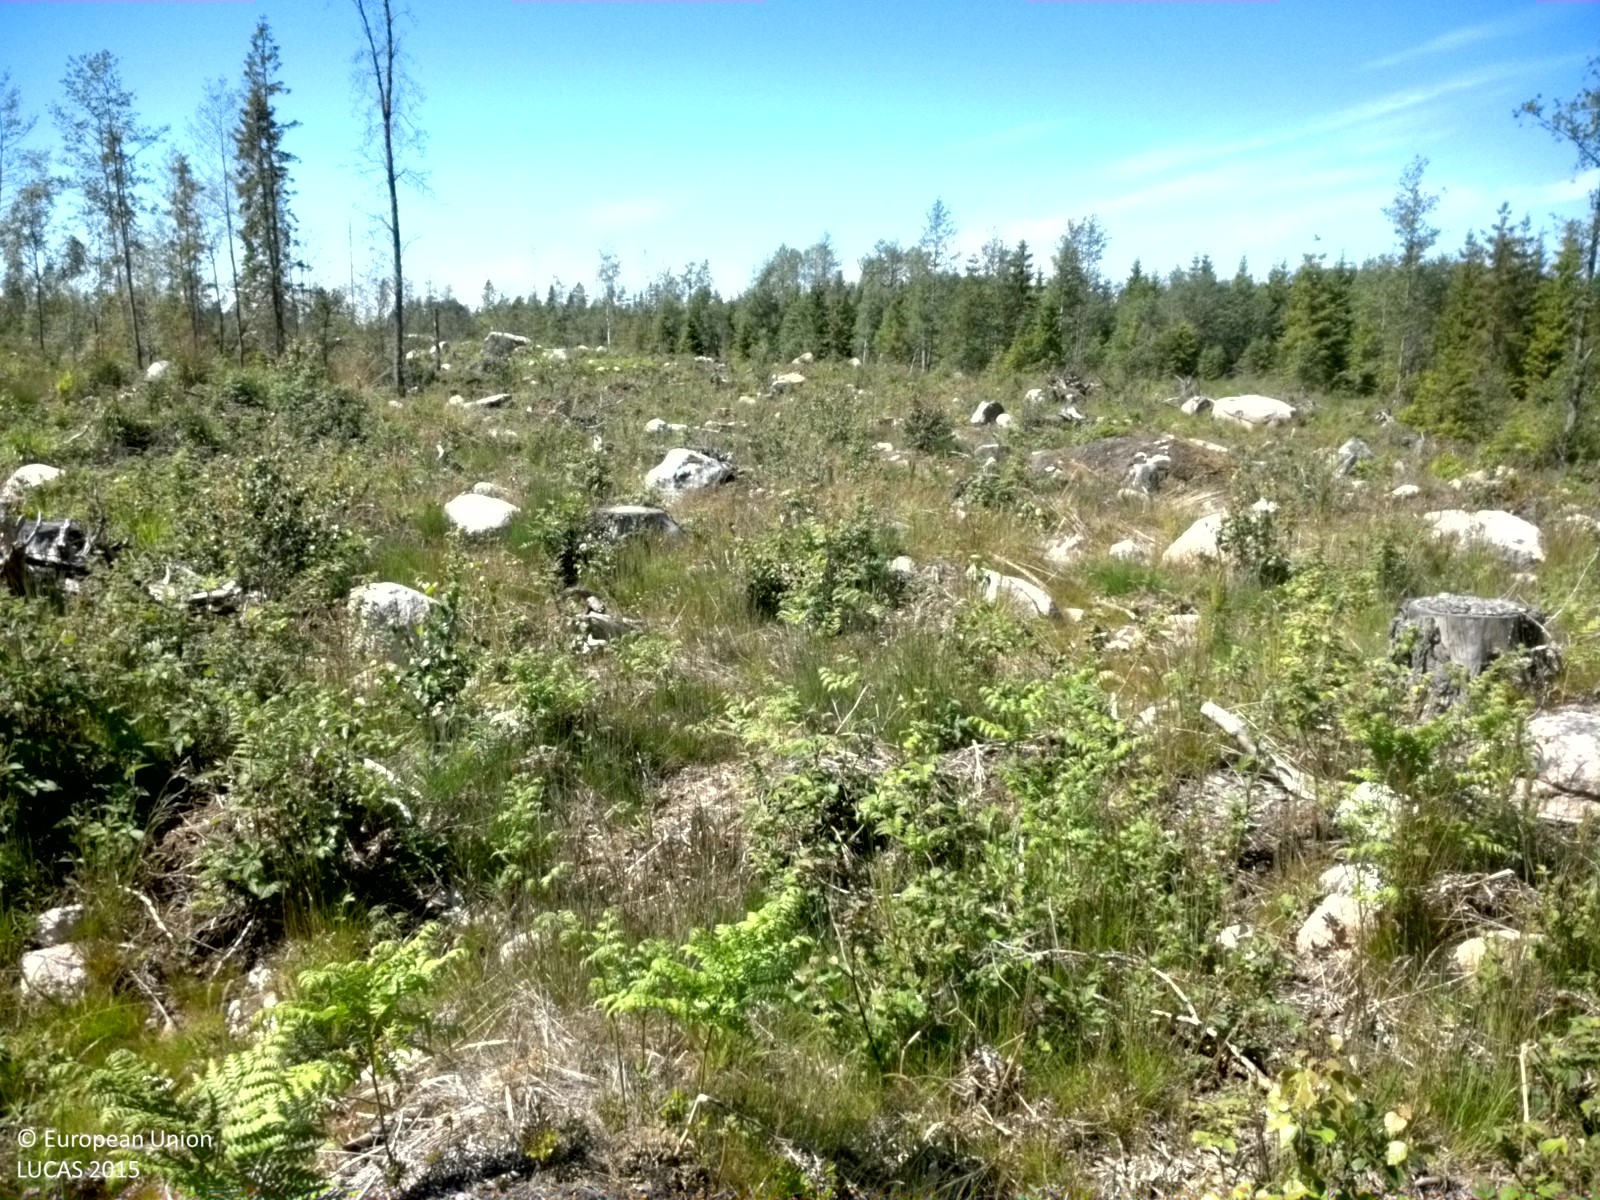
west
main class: Grassland
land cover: Grassland with sparse tree/shrub cover
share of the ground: > 75 %
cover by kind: herbaceous plants 65 %, shrubs 10 %, consolidated bare surface 10 %, broadleaved forest trees 5 %
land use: Forestry
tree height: > 5 m
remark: Clear cut
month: June
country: SE
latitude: 60.2472
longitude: 17.5978
